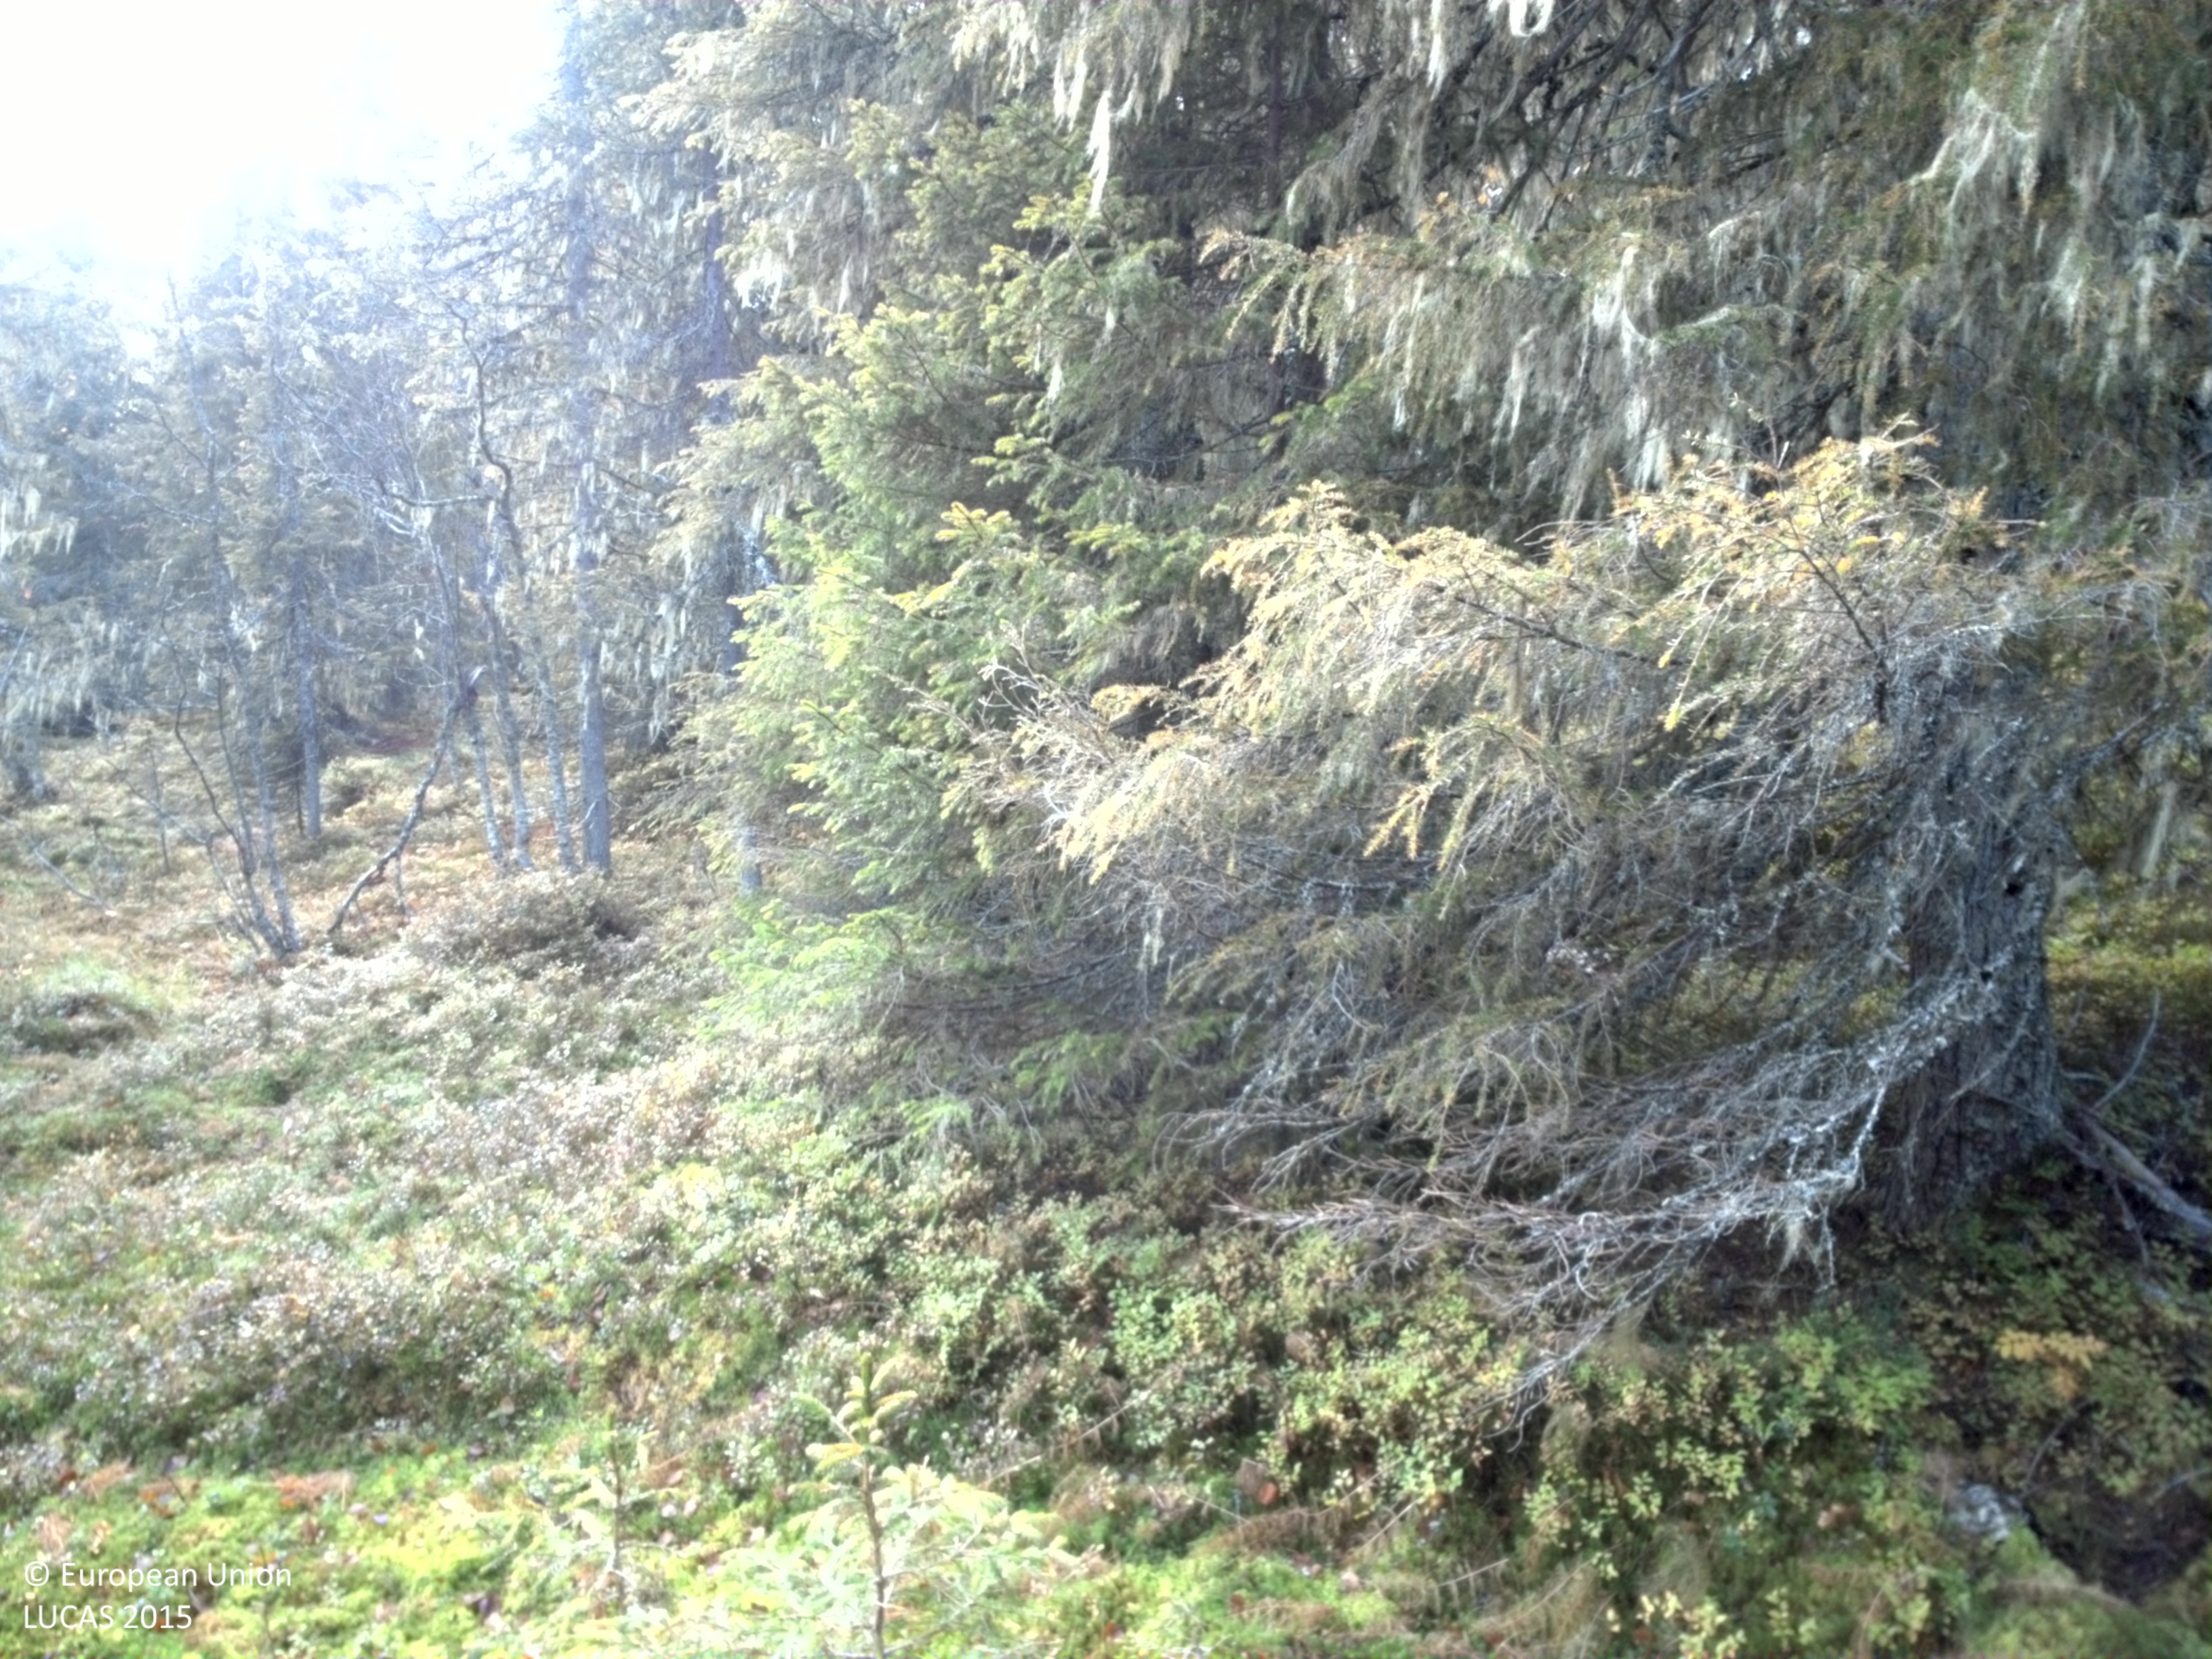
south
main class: Woodland
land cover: Spruce dominated coniferous woodland
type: boreal forest
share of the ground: 25 - 50 %
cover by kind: shrubs 40 %, coniferous forest trees 30 %, lichens and mosses 15 %, herbaceous plants 10 %, broadleaved forest trees 5 %
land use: Forestry
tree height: > 5 m
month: October
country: SE
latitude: 64.7270
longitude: 17.5439
